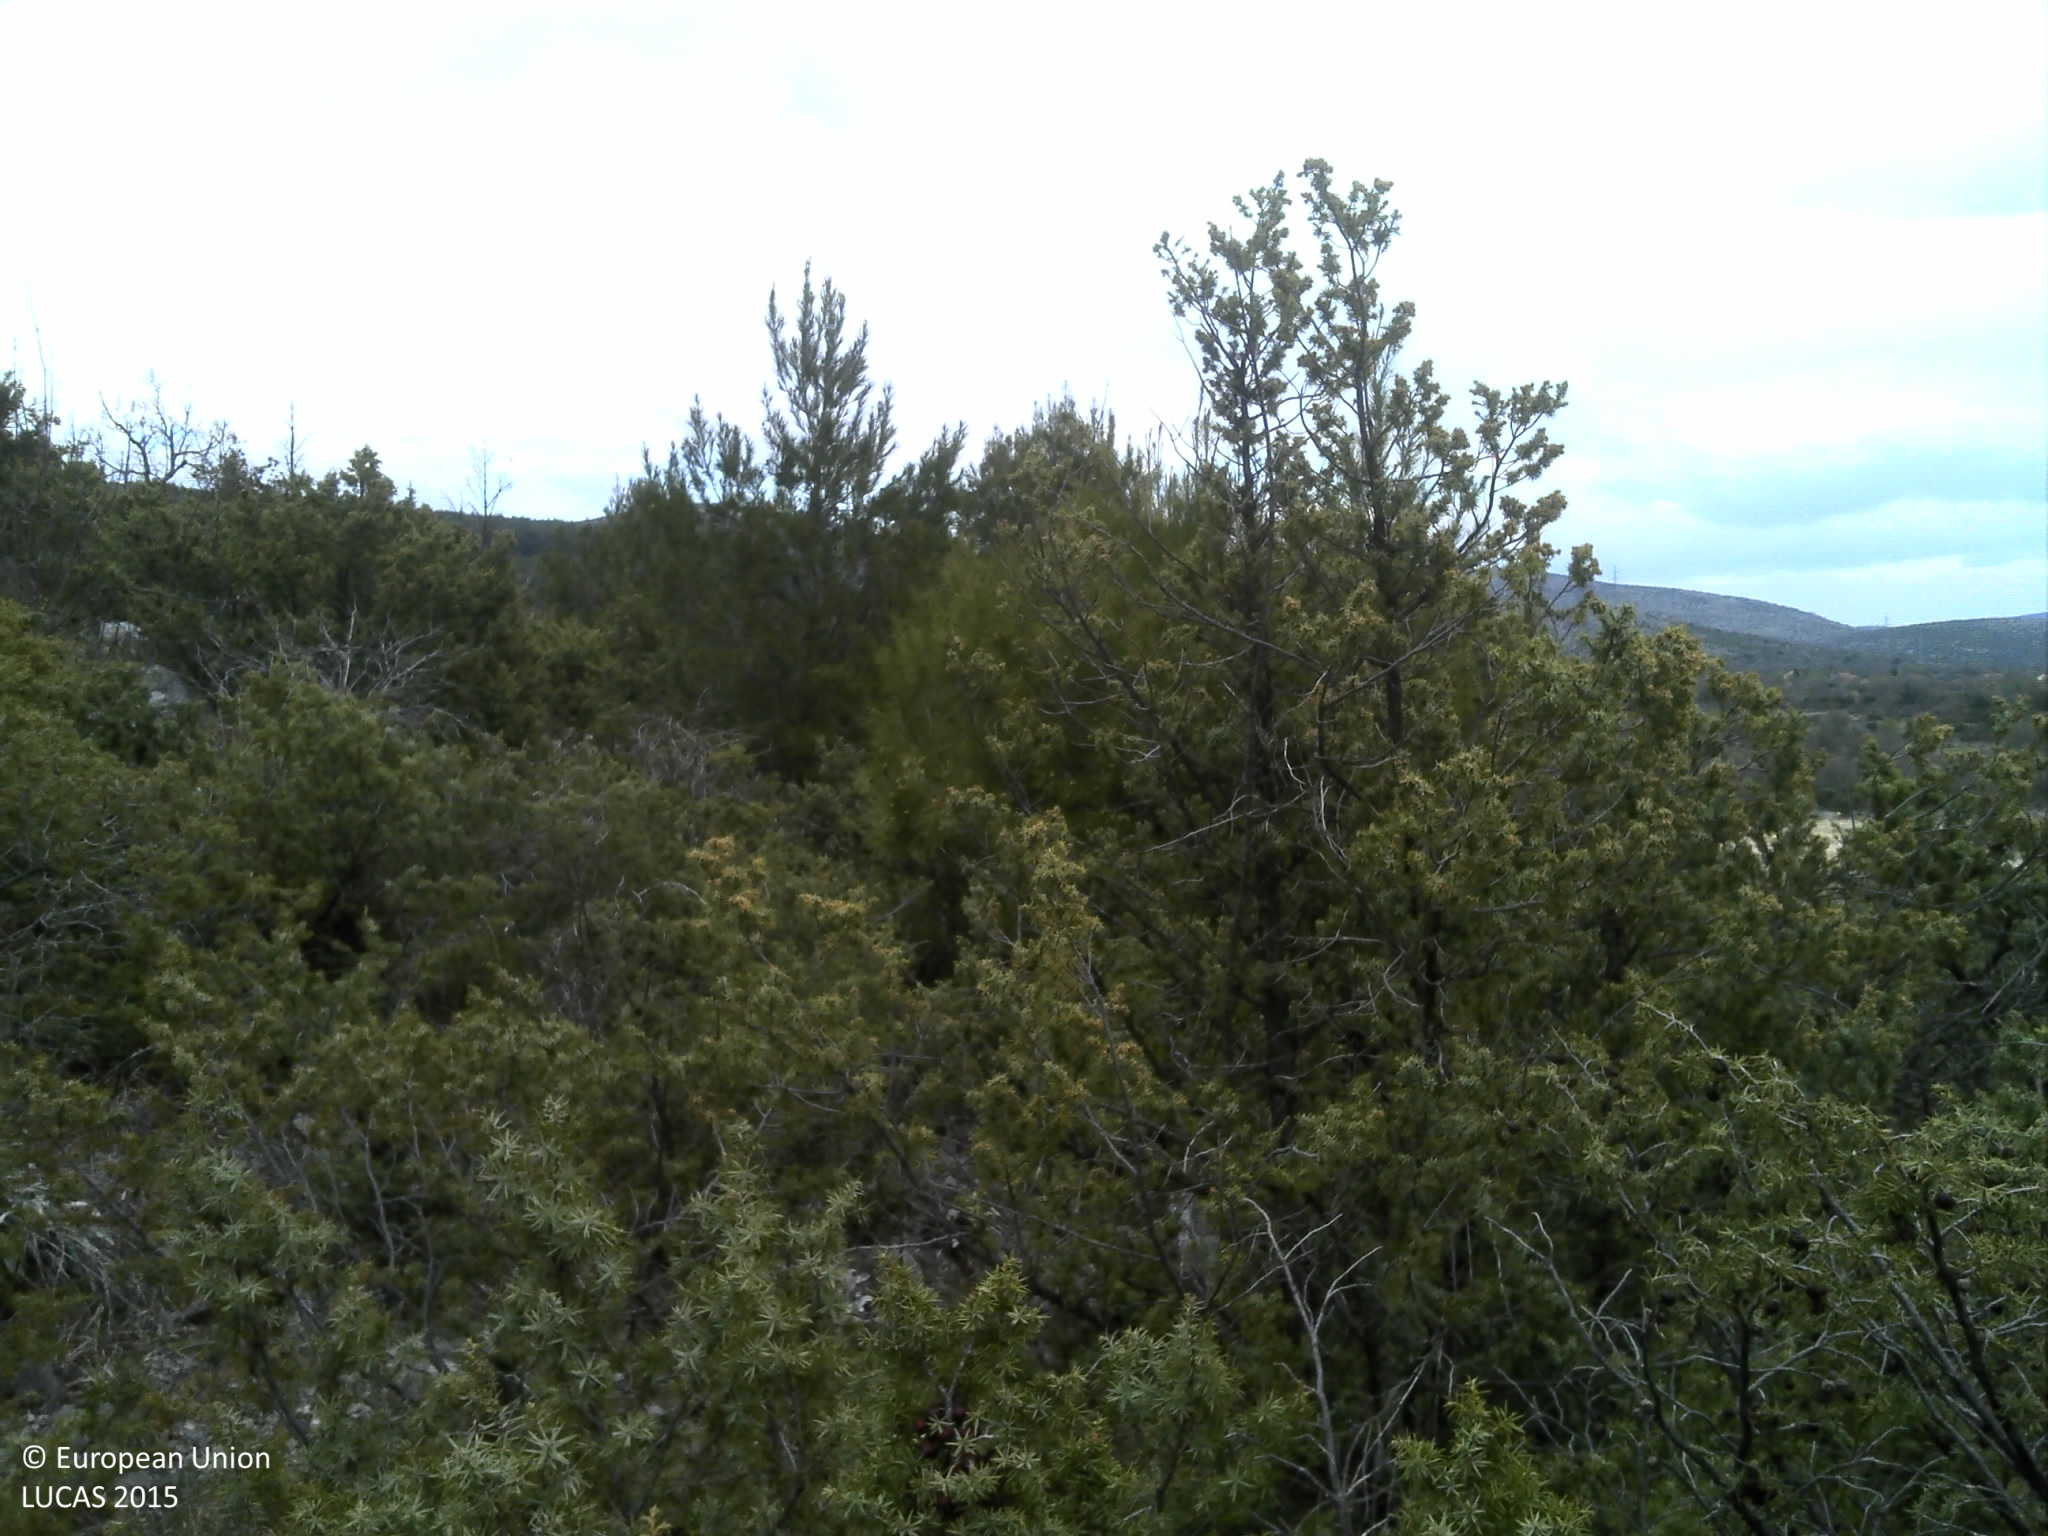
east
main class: Woodland
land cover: Other mixed woodland
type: coniferous forest of the mediterranean region
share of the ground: 50 - 75 %
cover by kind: coniferous forest trees 35 %, shrubs 25 %, broadleaved forest trees 15 %, consolidated bare surface 10 %, unconsolidated bare surface 10 %, herbaceous plants 5 %
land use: Semi-natural and natural areas not in use
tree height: < 5 m
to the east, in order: Other mixed woodland; Shrubland with sparse tree cover; Tracks; Grassland without tree/shrub cover; Paved roads, cycling and walking lanes; Shrubland without tree cover; Rocks and stones; Broadleaved woodland; Dry stone walls; Broadleaved woodland
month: April
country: HR
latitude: 43.6838
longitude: 16.0820
